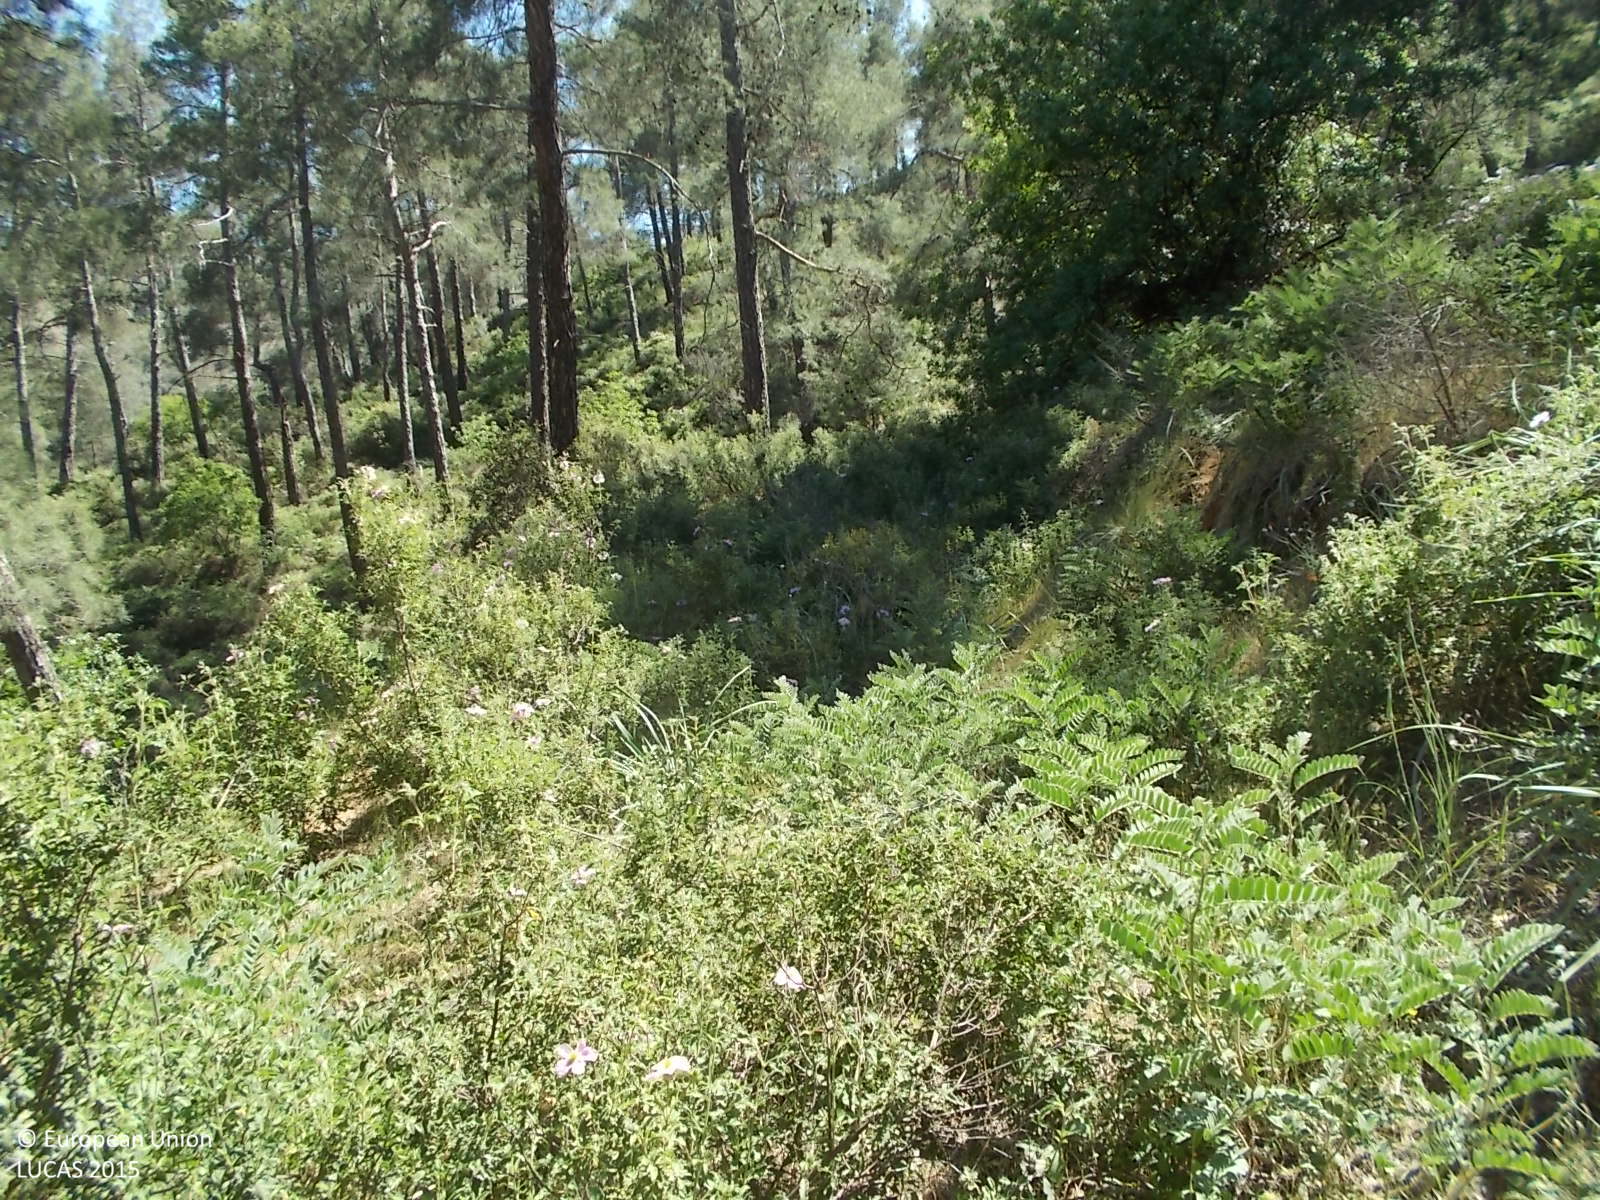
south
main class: Woodland
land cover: Pine dominated coniferous woodland
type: coniferous forest of the mediterranean region
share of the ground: > 75 %
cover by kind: coniferous forest trees 100 %
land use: Semi-natural and natural areas not in use
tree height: > 5 m
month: May
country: CY
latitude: 34.9470
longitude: 33.2075
